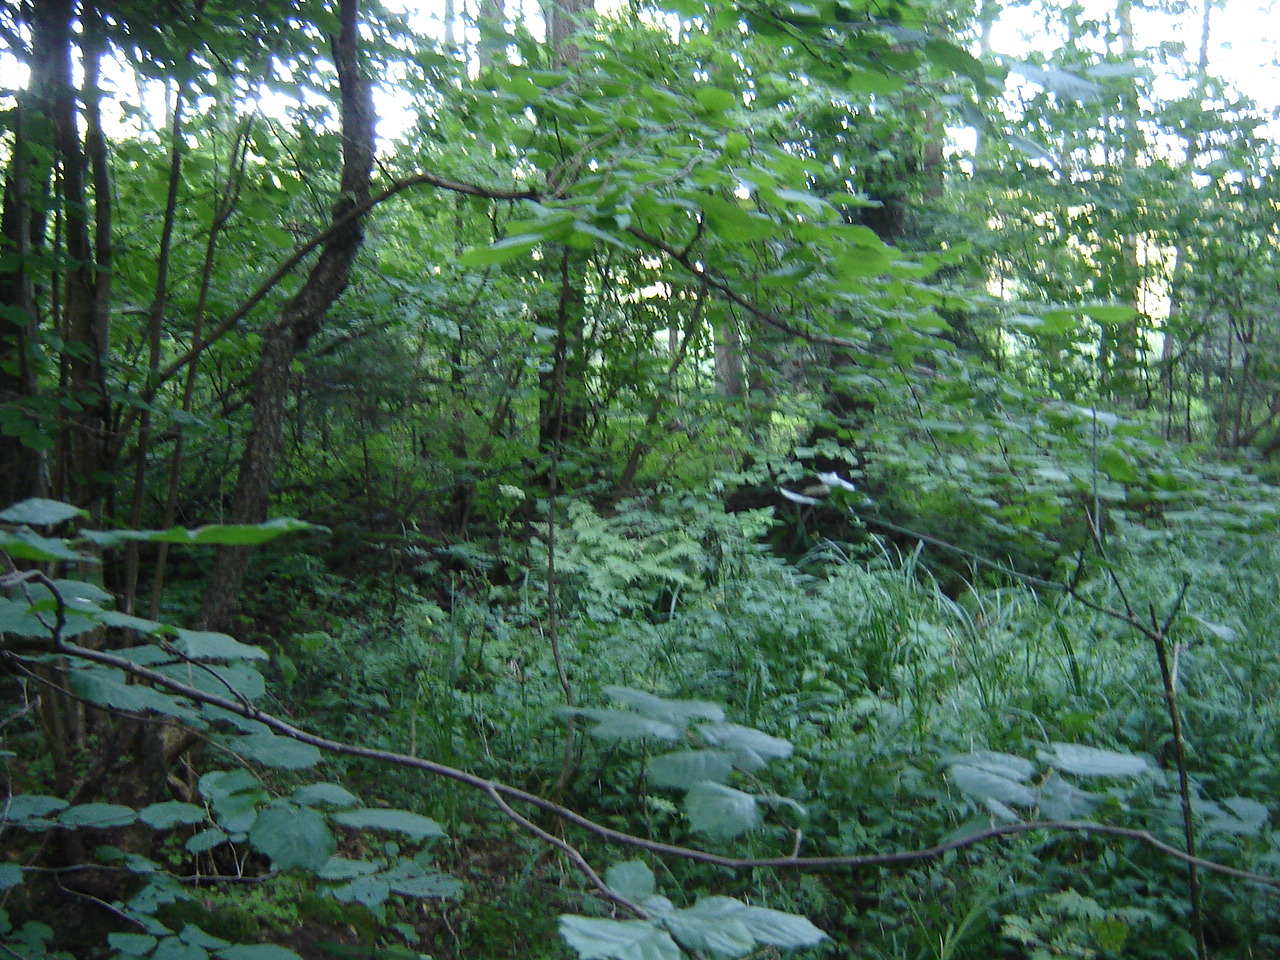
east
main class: Woodland
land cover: Other mixed woodland
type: hemiboreal forest and nemoral coniferous forest and mixed broadleaved-coniferous forest
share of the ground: > 75 %
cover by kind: broadleaved forest trees 50 %, coniferous forest trees 45 %, lichens and mosses 5 %
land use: Forestry
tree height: > 5 m
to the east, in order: Other mixed woodland; Broadleaved woodland; Other mixed woodland
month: August
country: LT
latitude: 55.0528
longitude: 25.0640
